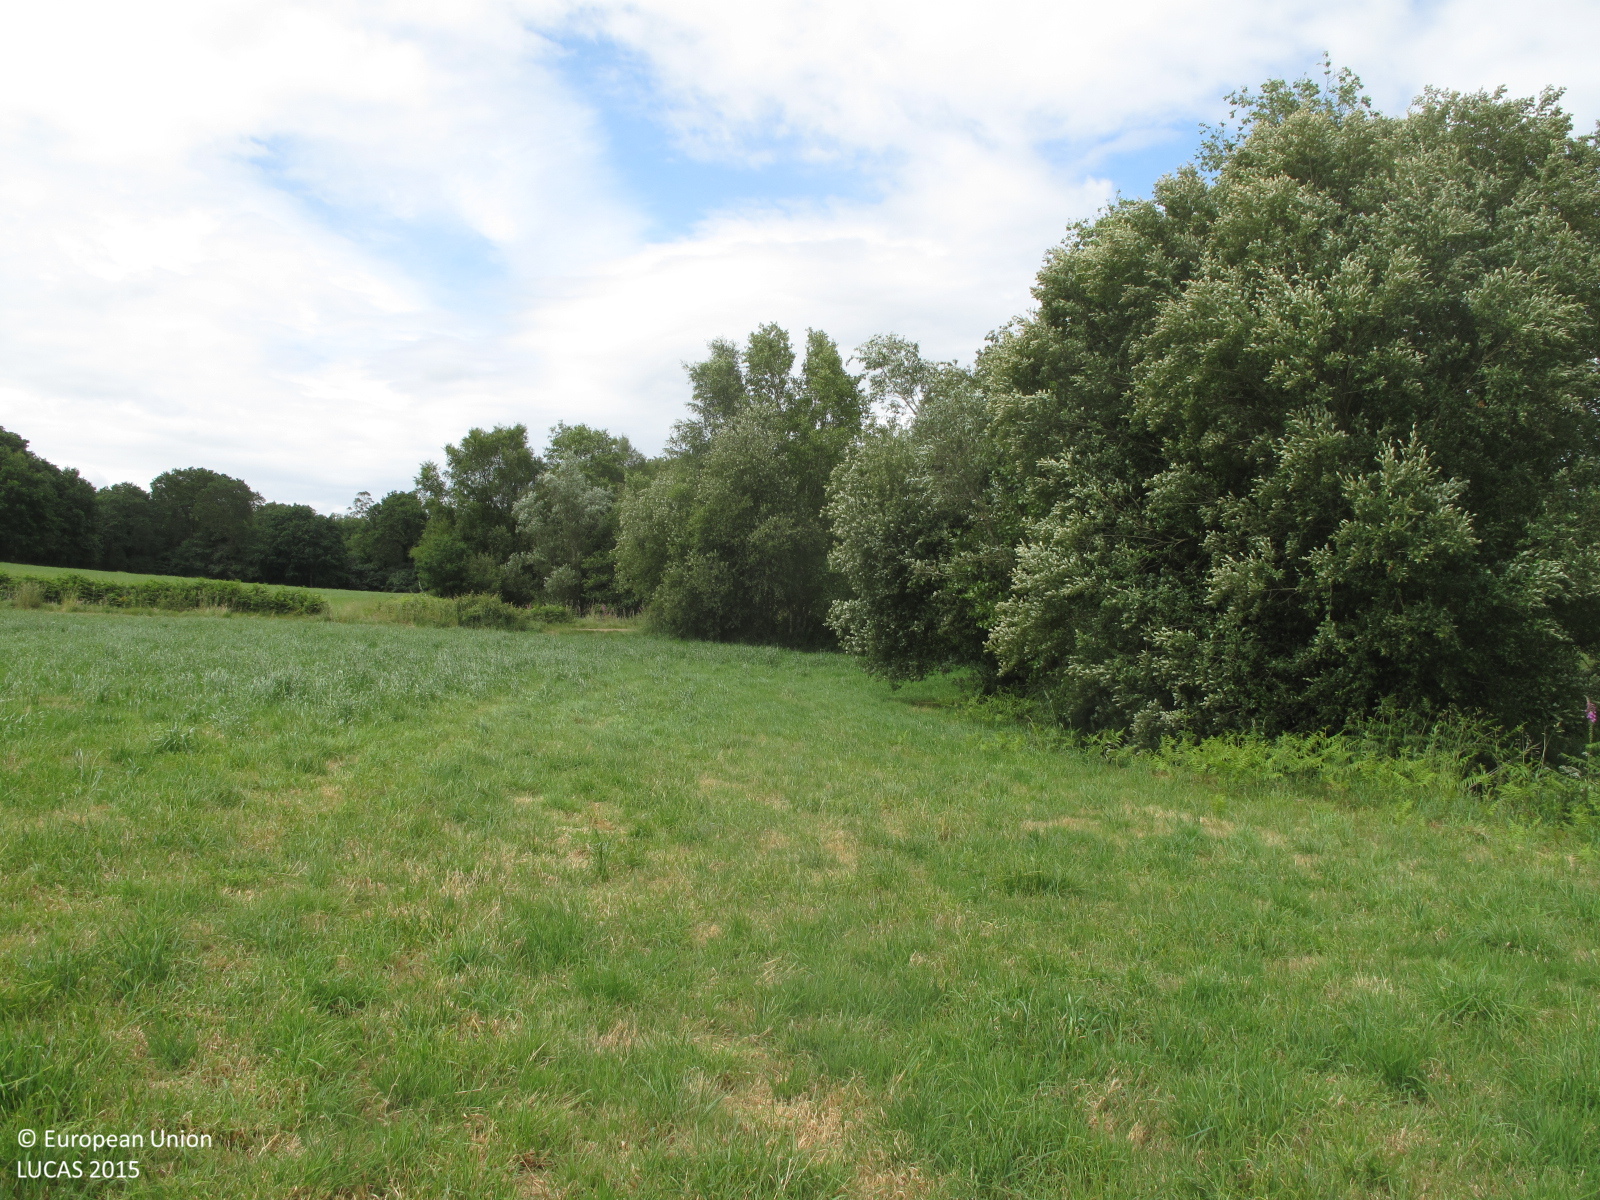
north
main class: Grassland
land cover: Grassland without tree/shrub cover
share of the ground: > 75 %
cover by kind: herbaceous plants 100 %
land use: Agriculture (excluding fallow land and kitchen gardens)
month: June
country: ES
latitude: 43.0288
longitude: -8.5526
